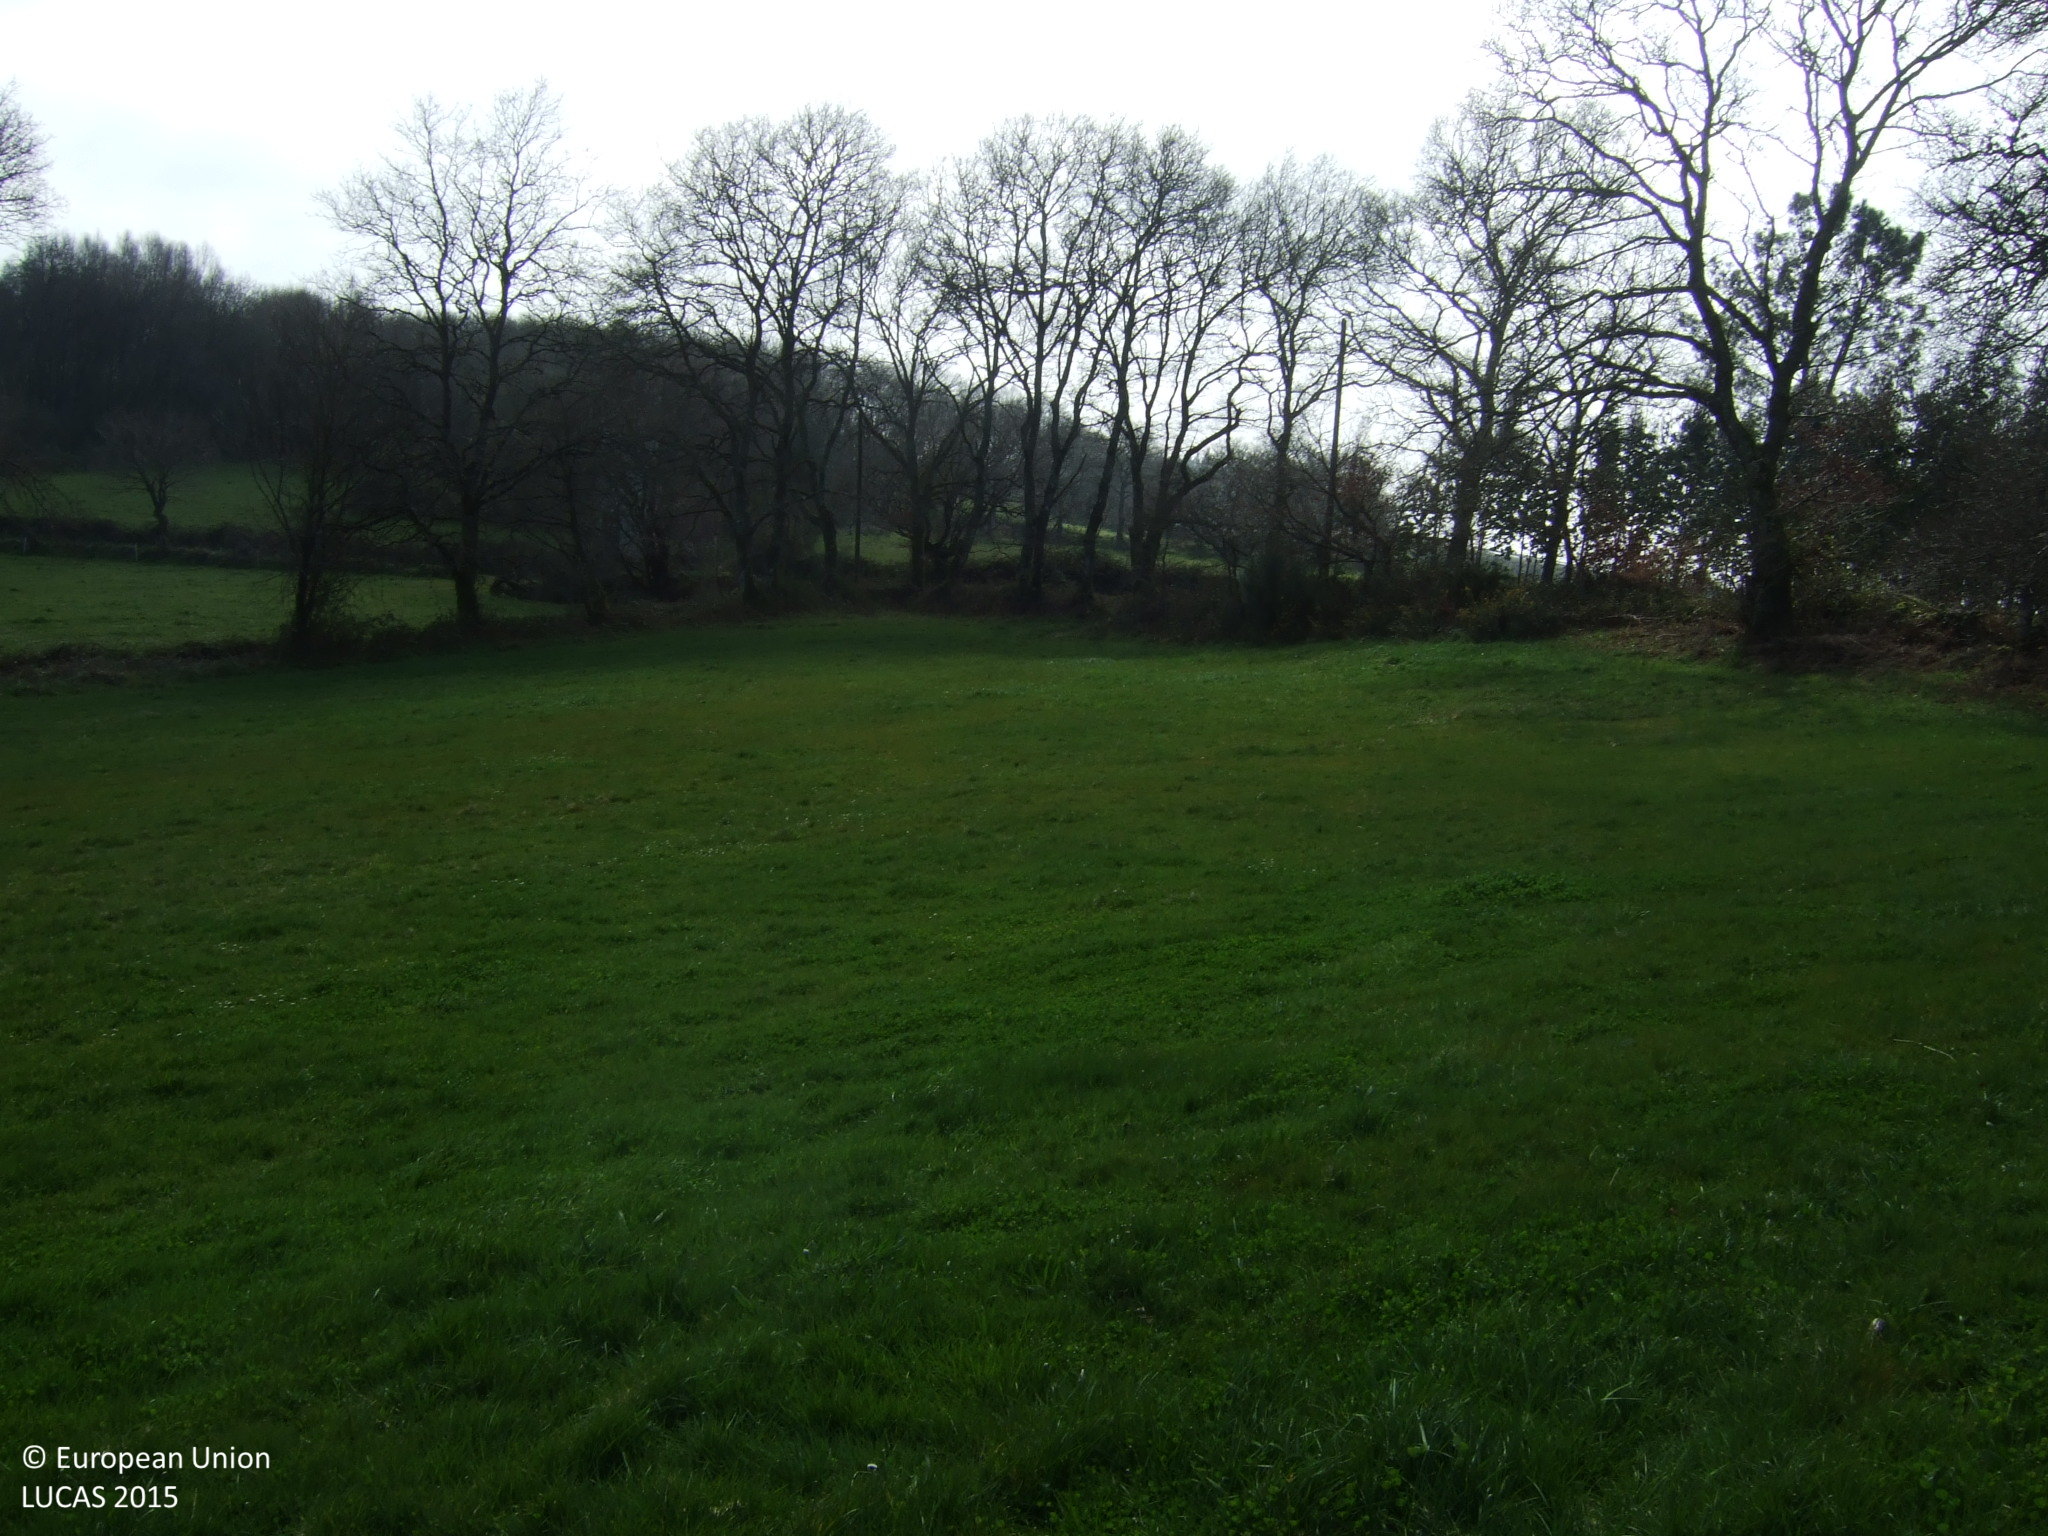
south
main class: Grassland
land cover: Grassland without tree/shrub cover
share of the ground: > 75 %
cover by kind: herbaceous plants 100 %
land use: Agriculture (excluding fallow land and kitchen gardens)
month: March
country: ES
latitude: 42.8931
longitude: -7.8776
